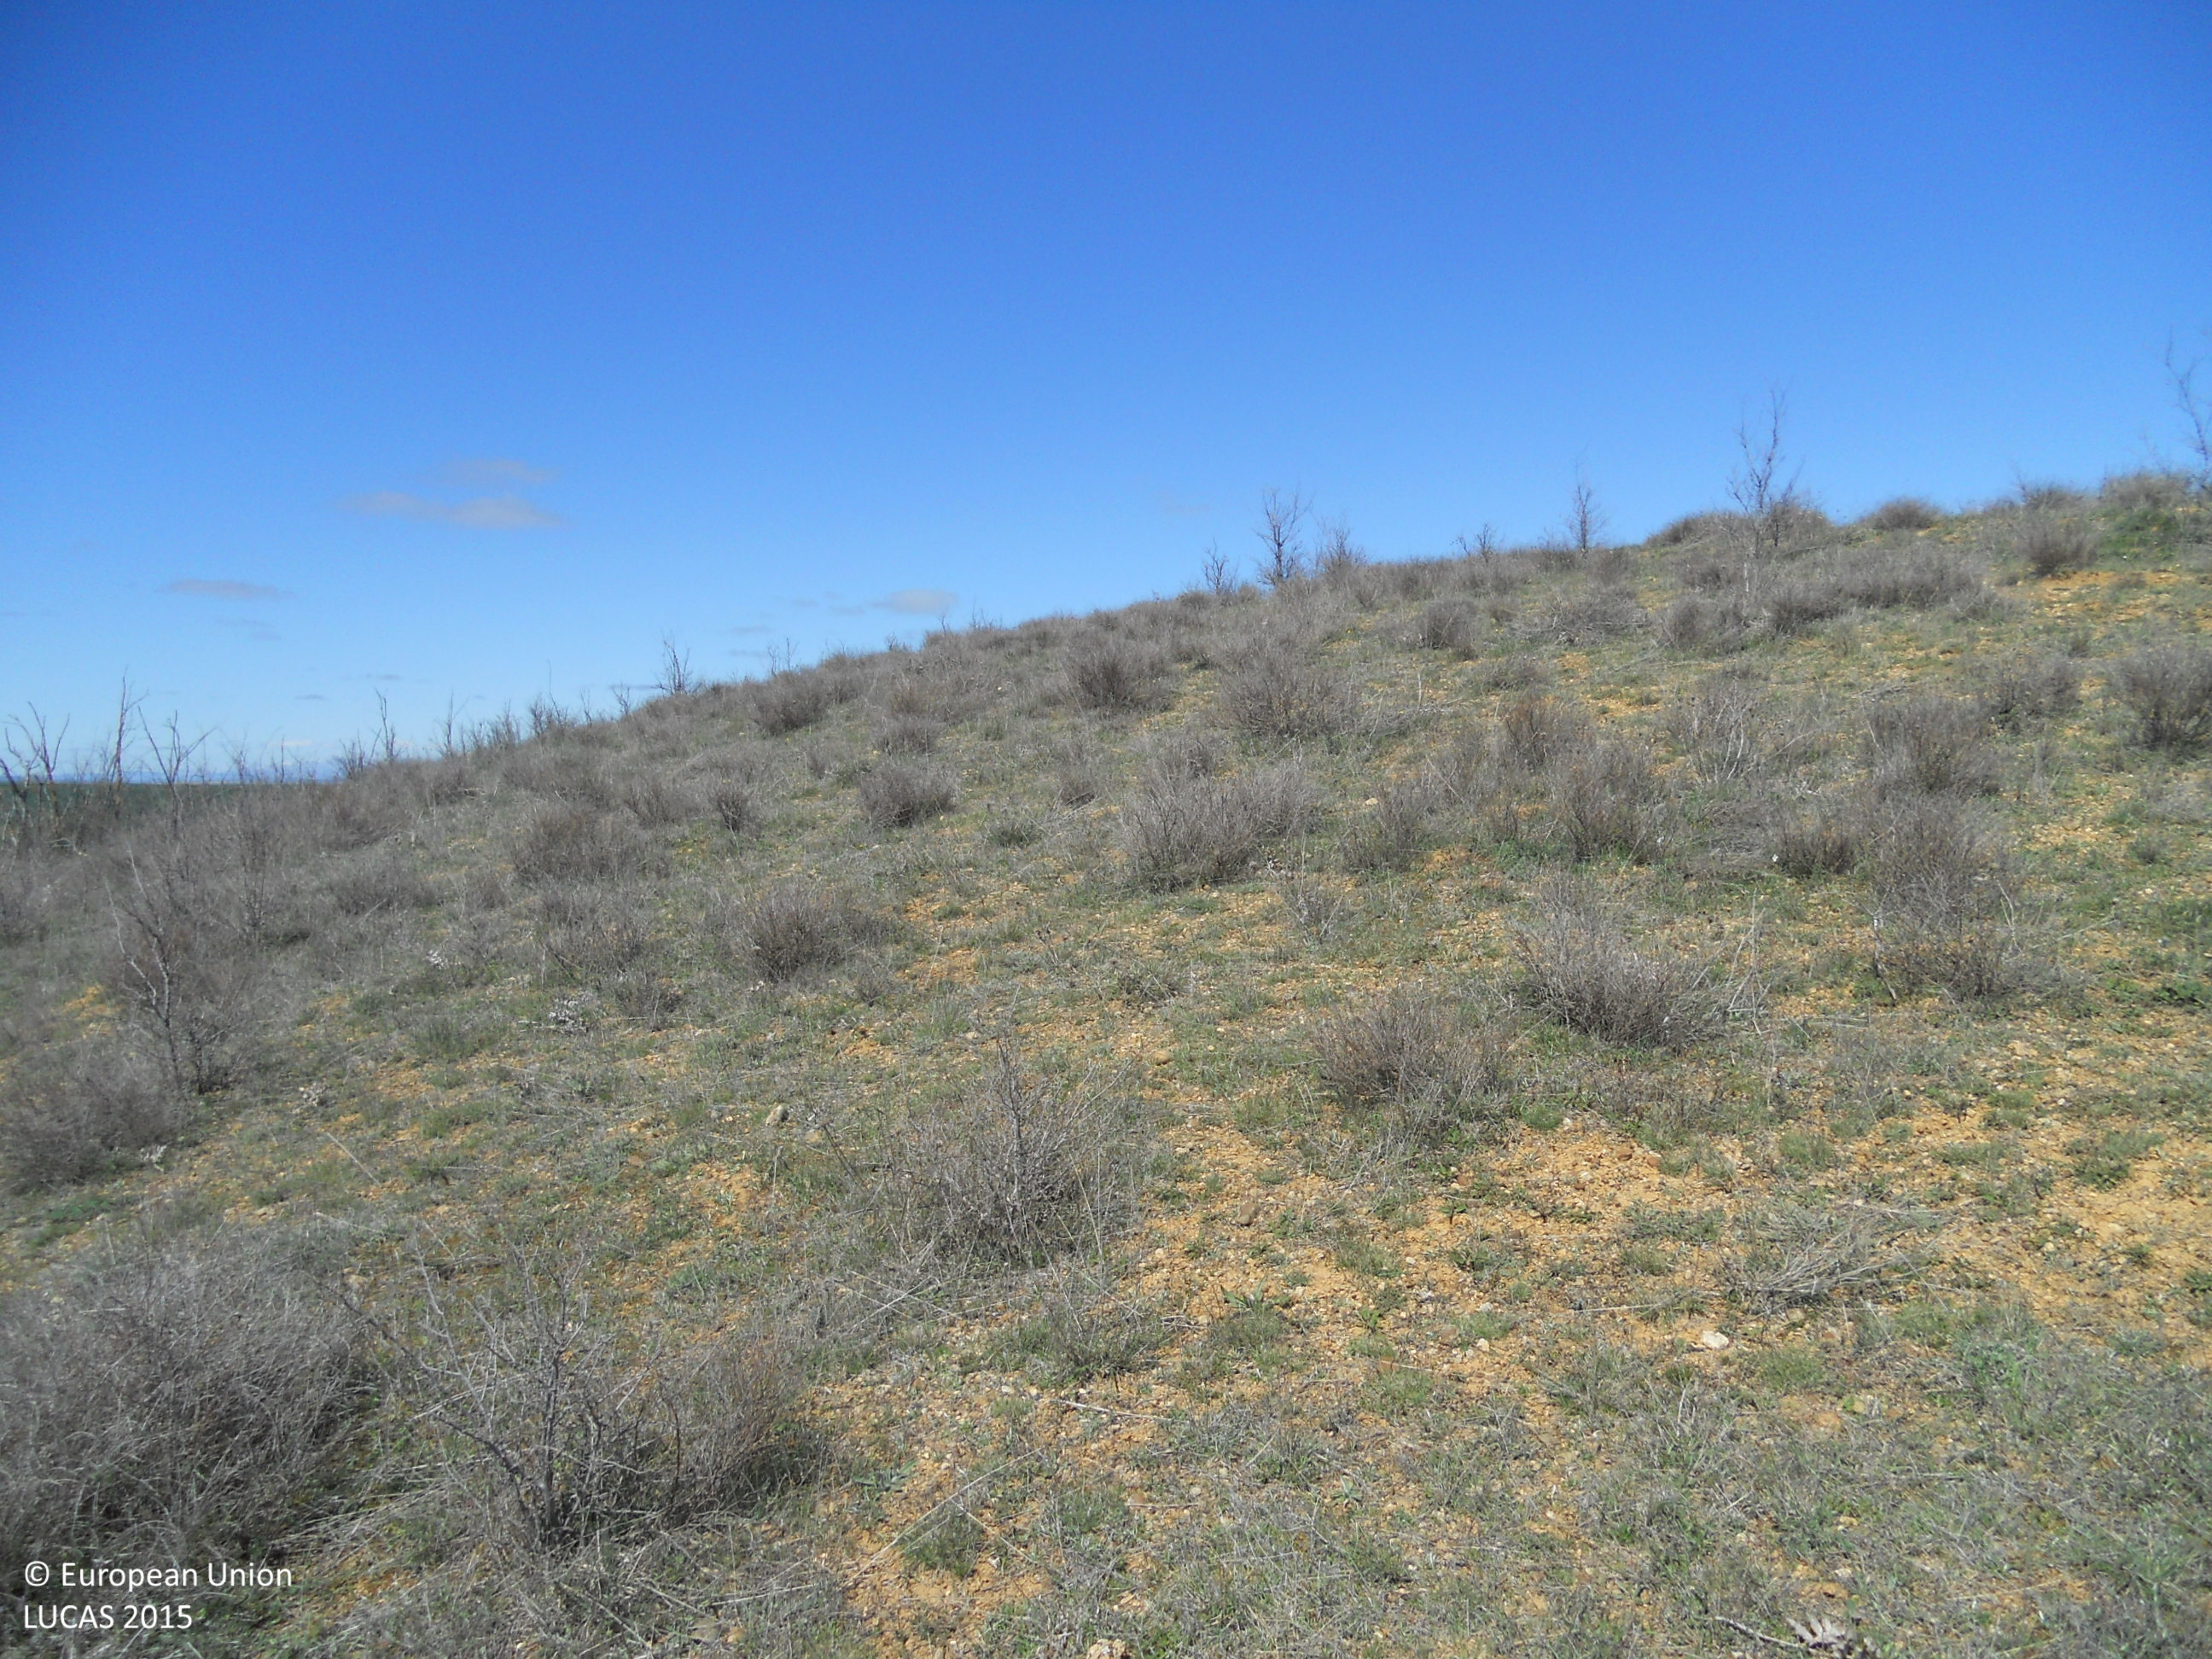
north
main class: Shrubland
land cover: Shrubland with sparse tree cover
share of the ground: 25 - 50 %
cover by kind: herbaceous plants 75 %, shrubs 20 %, broadleaved forest trees 5 %
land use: Semi-natural and natural areas not in use
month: April
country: ES
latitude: 42.3359
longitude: -4.3808
